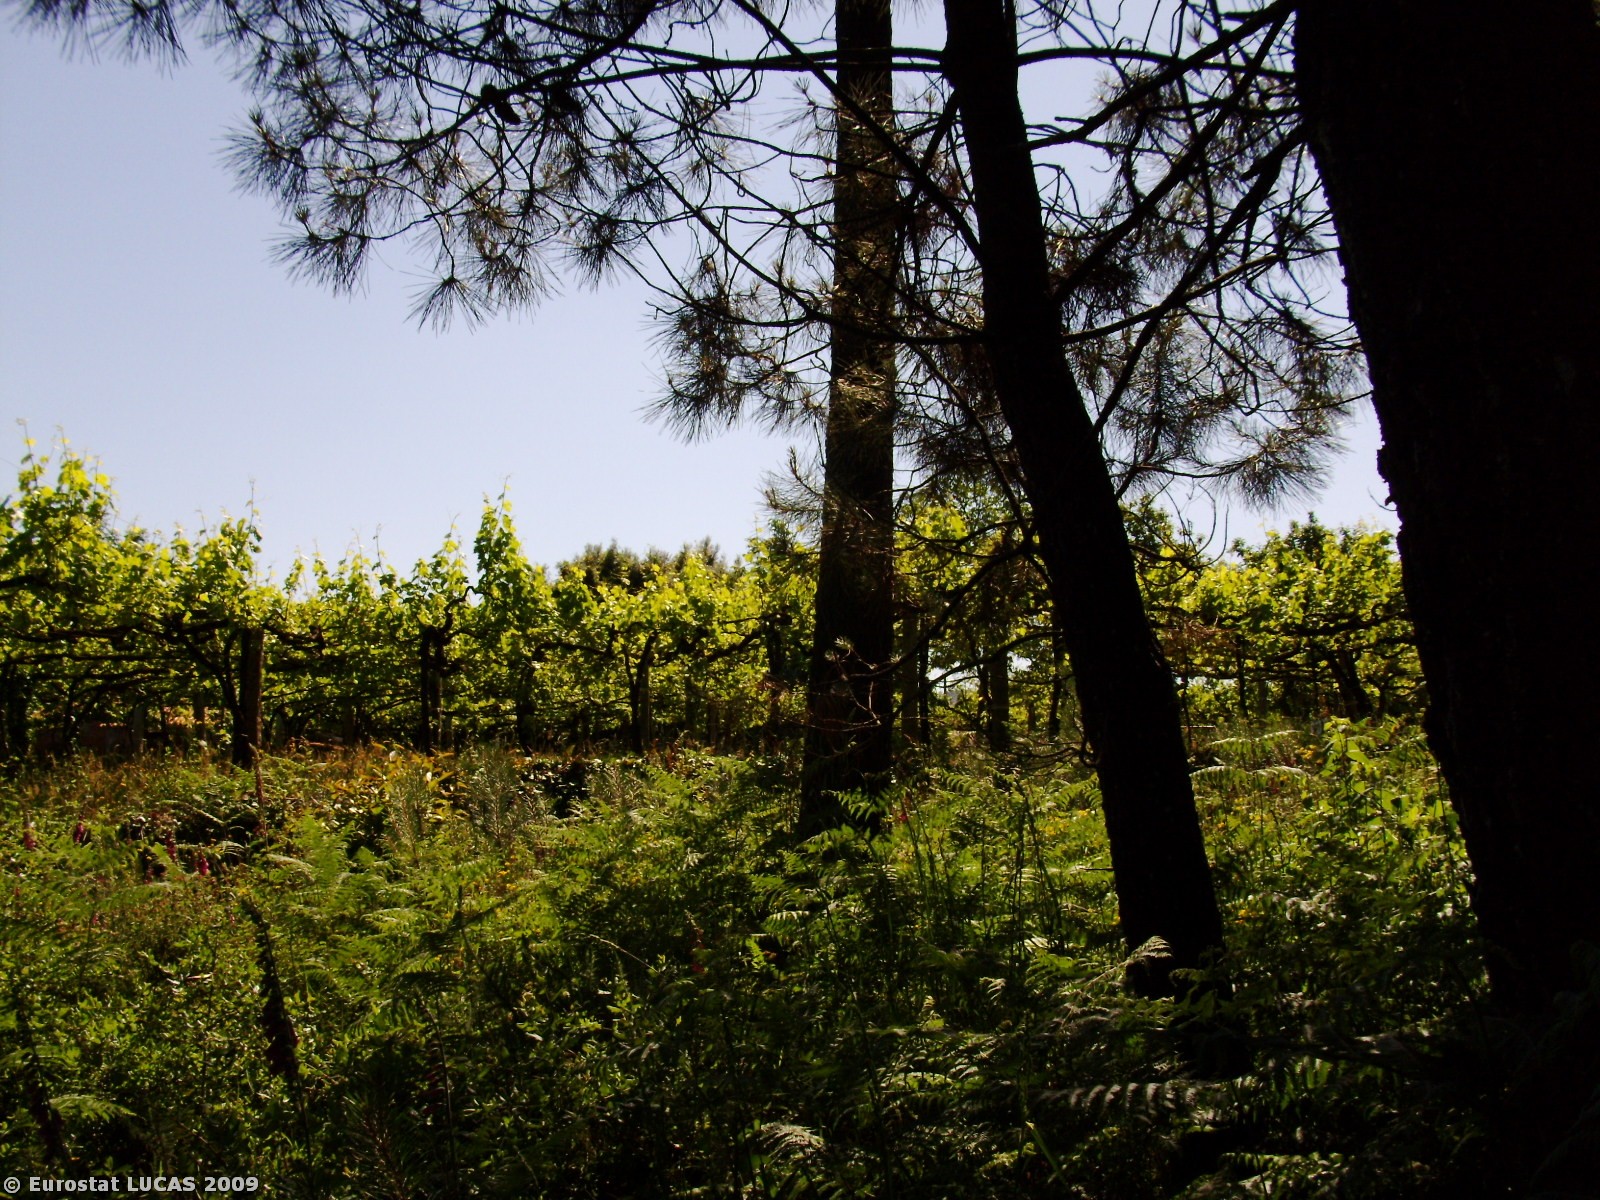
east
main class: Woodland
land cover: Mixed woodland
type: coniferous forest of the mediterranean region
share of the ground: > 75 %
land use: Forestry
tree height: > 5 m
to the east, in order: Mixed woodland; Vineyards; Spontaneously vegetated surfaces; Vineyards; Other fruit trees and berries; Vineyards; Dry stone walls; Paved roads, cycling and walking lanes; Dry stone walls; Artificial constructions in urban areas; Maize; Vineyards; Artificial constructions in urban areas; Other fruit trees and berries; Vineyards; Spontaneously vegetated surfaces
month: May
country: PT
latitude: 41.5971
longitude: -8.5999
